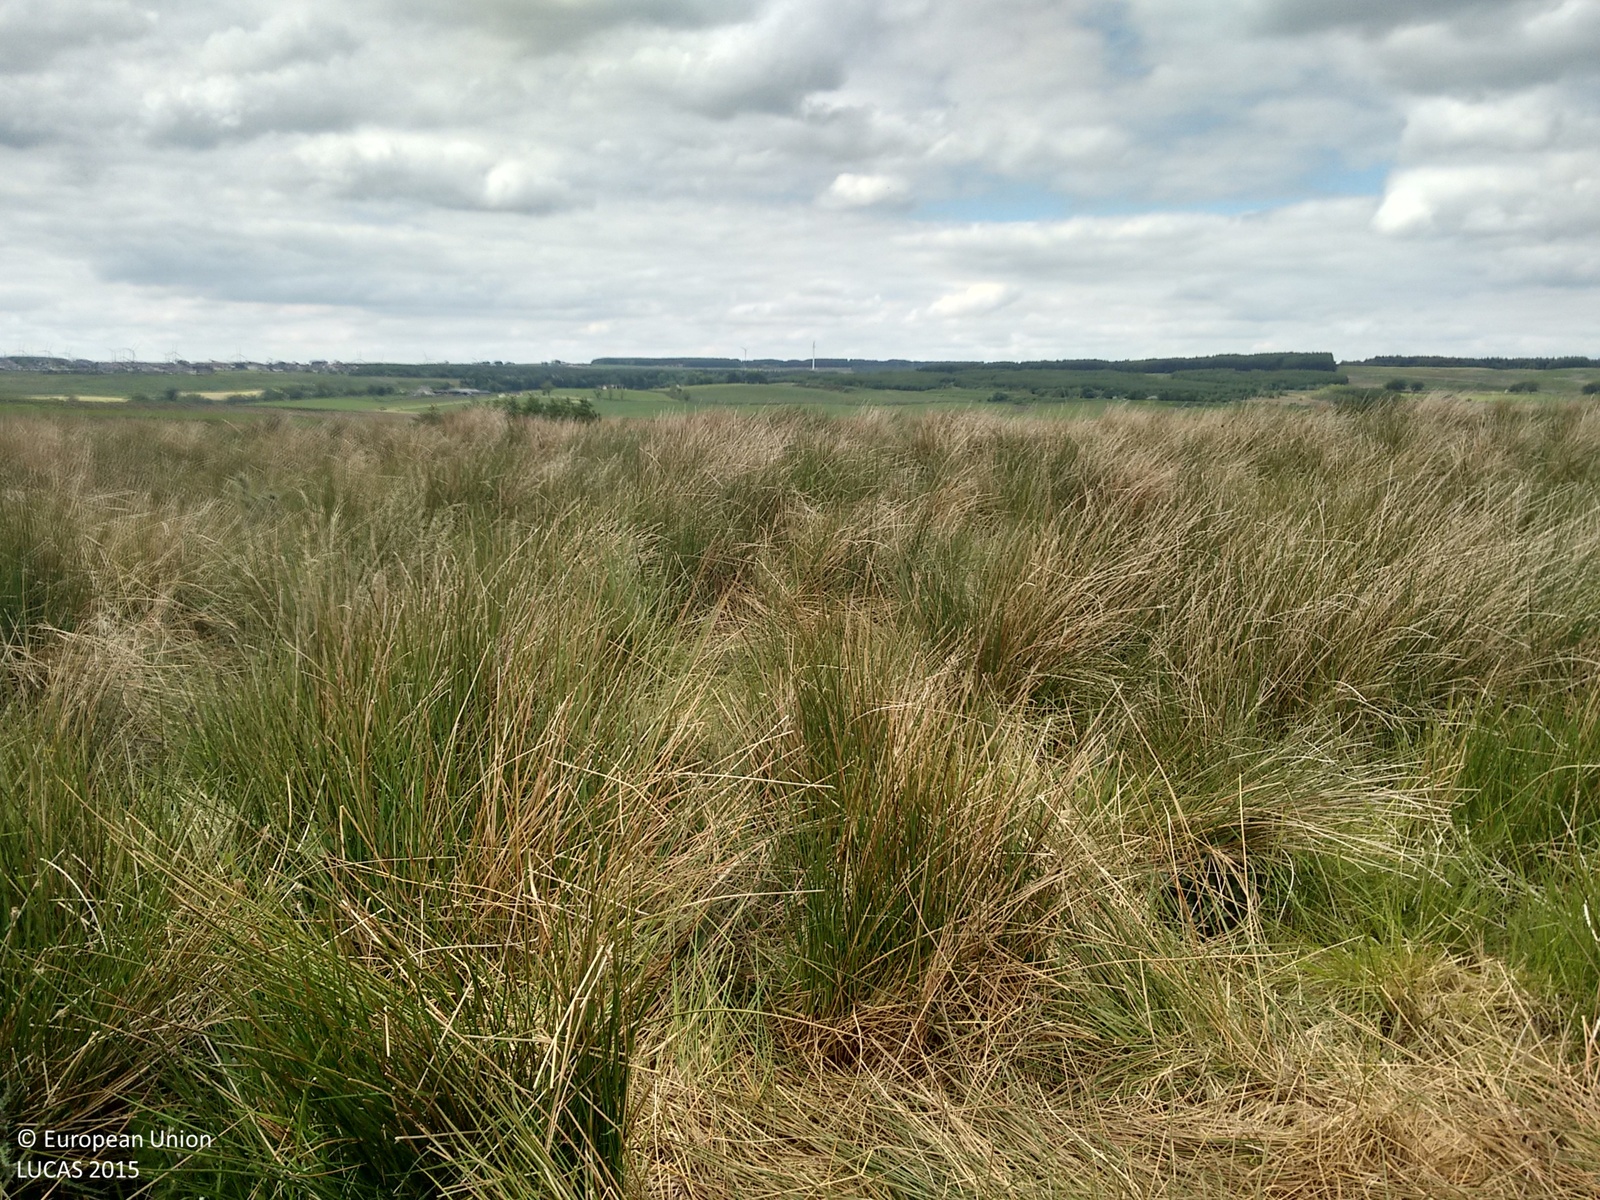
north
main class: Grassland
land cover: Grassland without tree/shrub cover
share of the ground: > 75 %
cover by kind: herbaceous plants 100 %
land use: Agriculture (excluding fallow land and kitchen gardens)
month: June
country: GB
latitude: 55.7648
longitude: -3.6441
